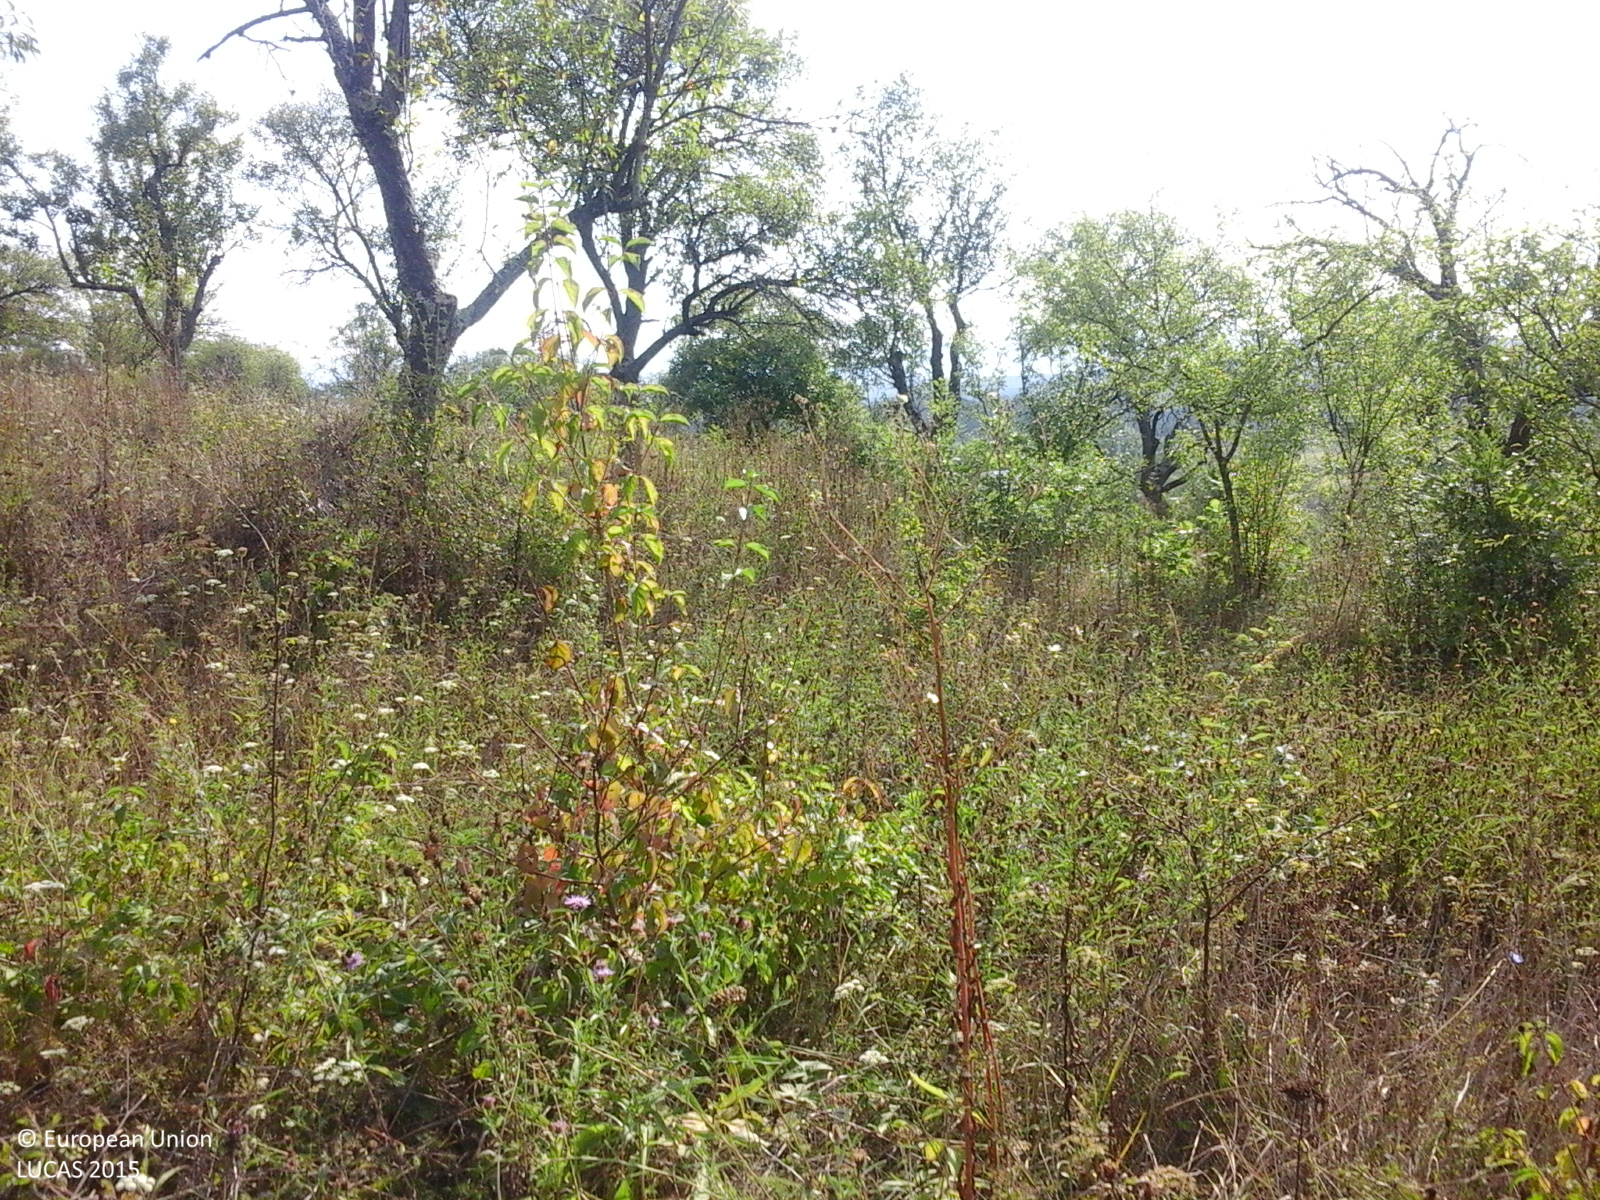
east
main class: Cropland
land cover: Apple fruit
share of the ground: 25 - 50 %
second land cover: Grassland without tree/shrub cover
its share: > 75 %
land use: Agriculture (excluding fallow land and kitchen gardens)
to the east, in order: Apple fruit; Grassland without tree/shrub cover; Fences; Other fruit trees and berries; Grassland without tree/shrub cover; Electric lines; Grassland without tree/shrub cover; Abandoned hedges; Artificial constructions in urban areas; Abandoned hedges
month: August
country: RO
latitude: 46.3837
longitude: 22.1512
